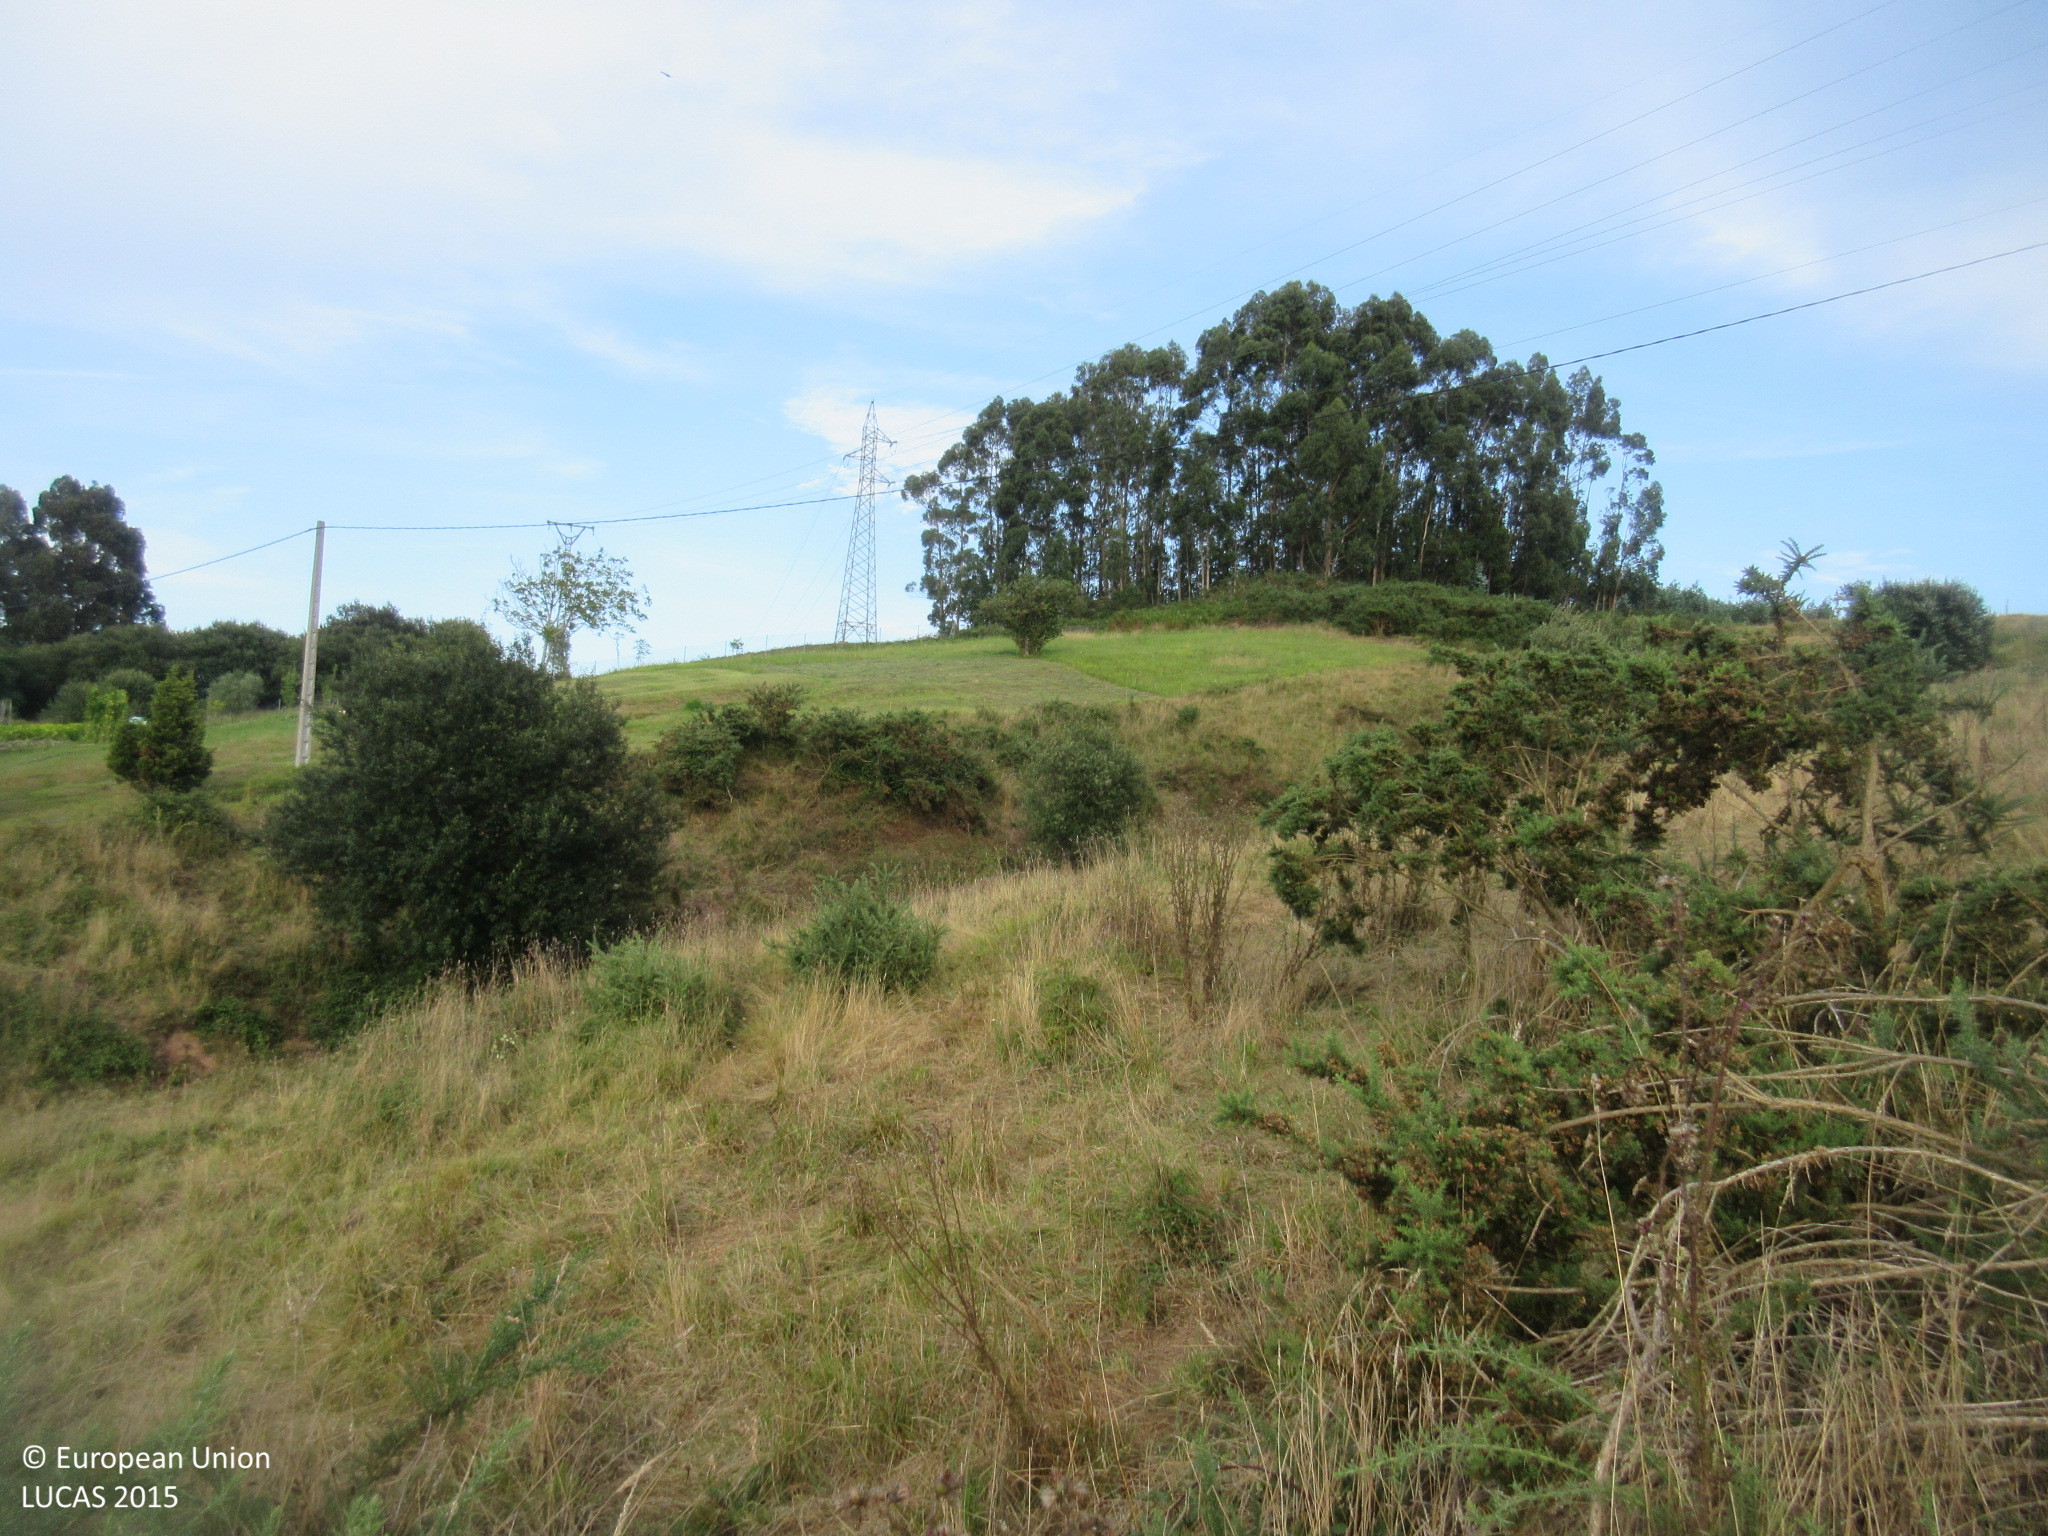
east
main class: Grassland
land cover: Grassland without tree/shrub cover
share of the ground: > 75 %
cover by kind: herbaceous plants 95 %, shrubs 5 %
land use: Agriculture (excluding fallow land and kitchen gardens)
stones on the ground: < 10 %
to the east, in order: Grassland without tree/shrub cover; Shrubland with sparse tree cover; Electric lines; Grassland without tree/shrub cover; Electric lines; Grassland without tree/shrub cover; Fences; Grassland without tree/shrub cover; Broadleaved woodland
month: July
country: ES
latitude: 43.3729
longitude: -4.0352
